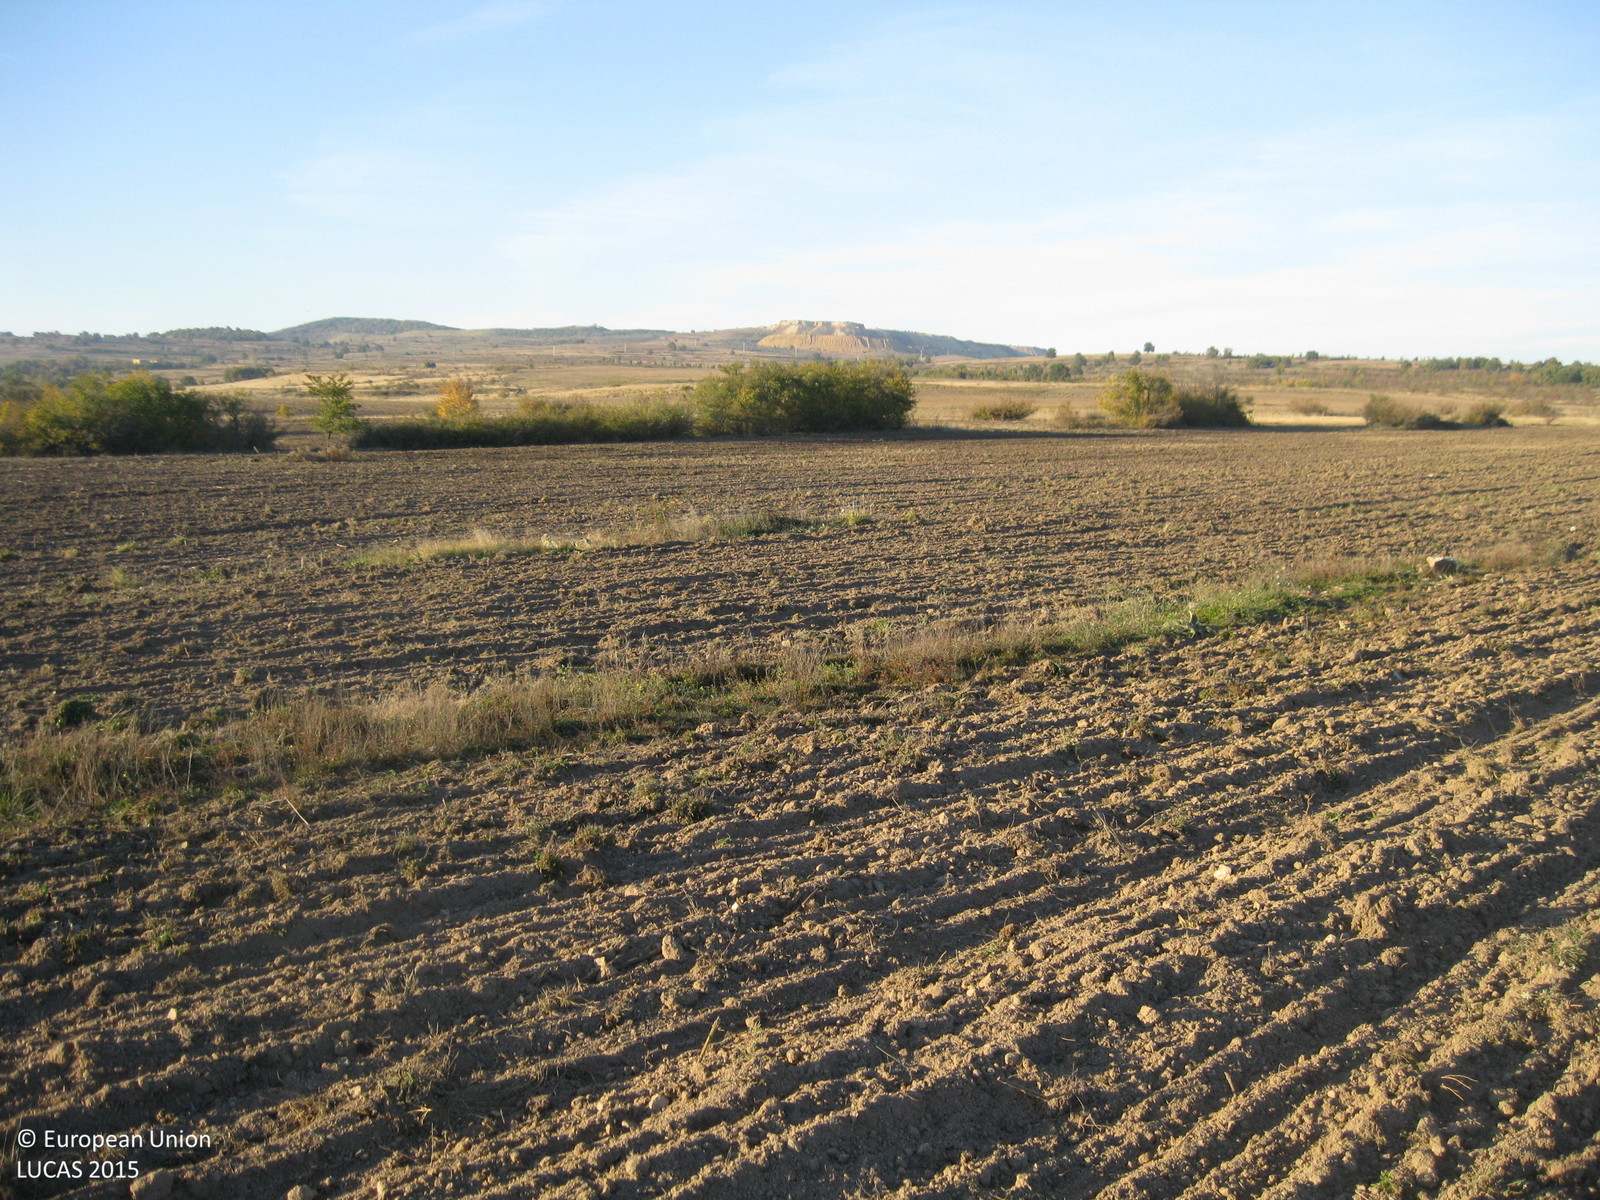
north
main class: Cropland
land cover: Sunflower
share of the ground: < 10 %
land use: Agriculture (excluding fallow land and kitchen gardens)
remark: Harvested field
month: November
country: BG
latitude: 42.3210
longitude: 24.2291
